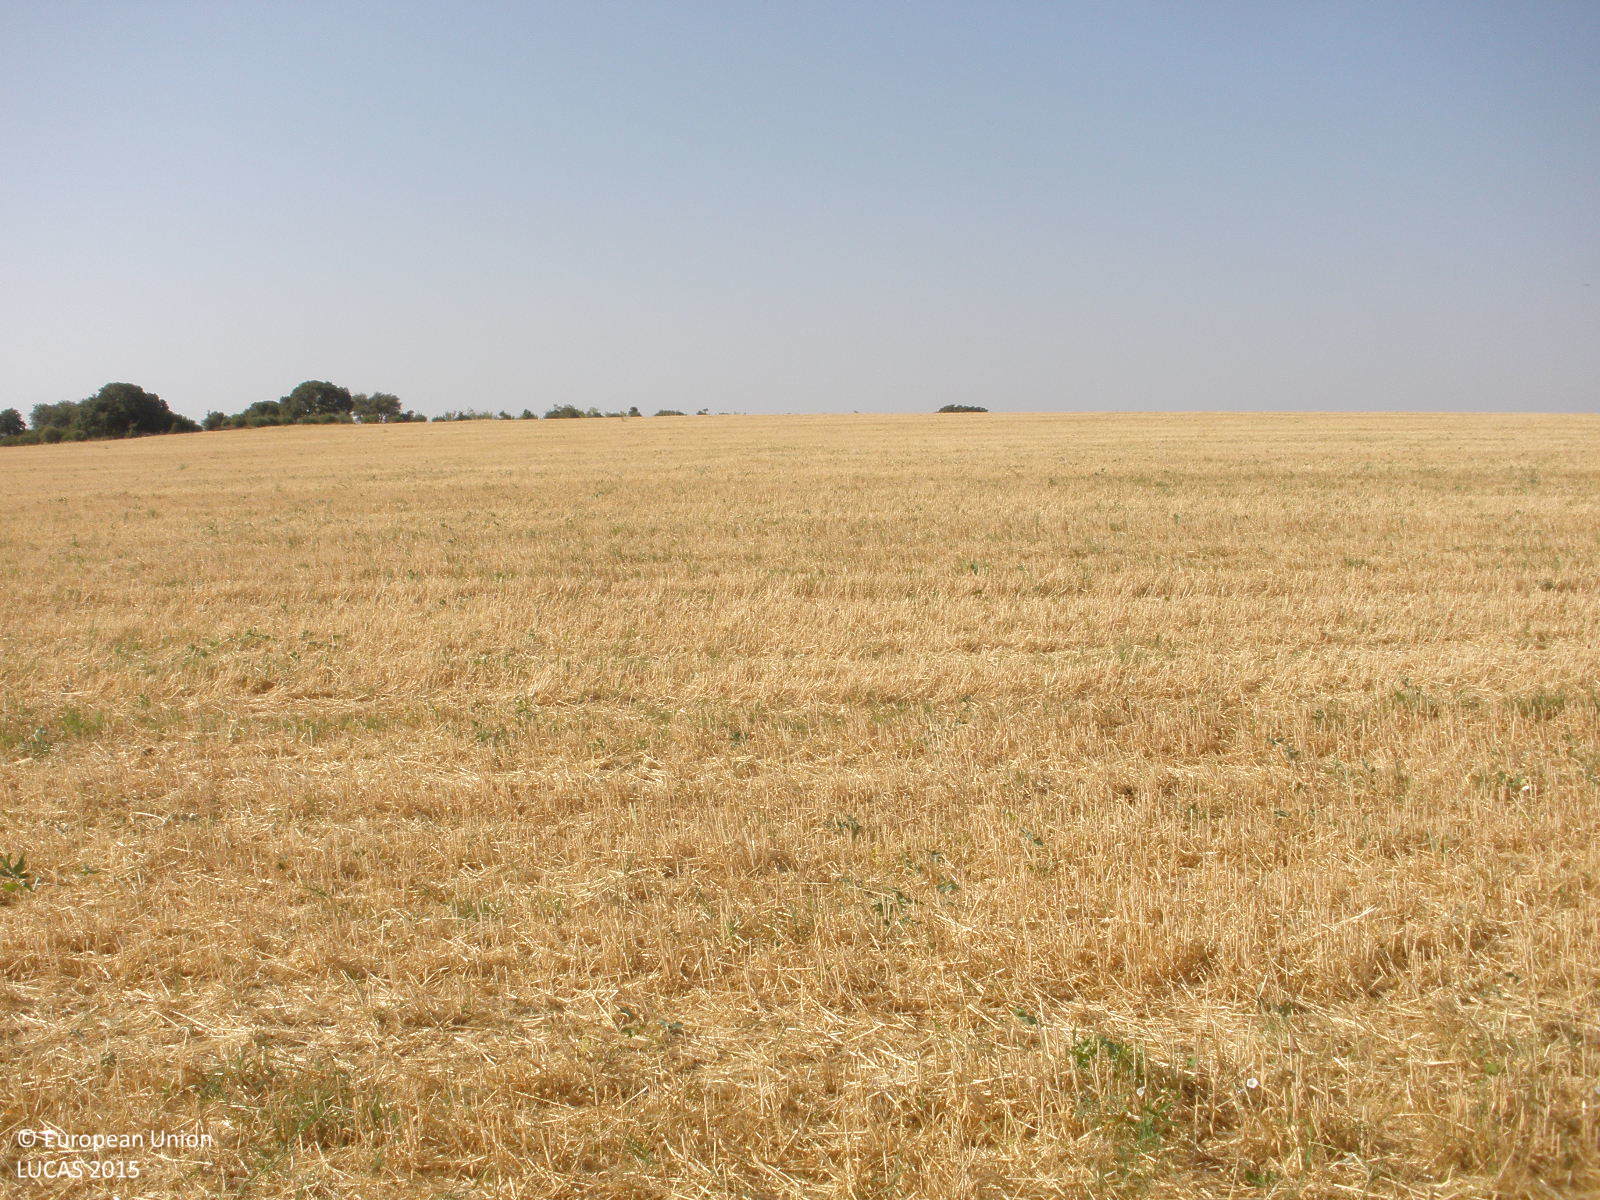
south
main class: Cropland
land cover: Barley
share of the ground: < 10 %
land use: Agriculture (excluding fallow land and kitchen gardens)
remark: Harvested field
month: July
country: ES
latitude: 40.2507
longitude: -3.3271
